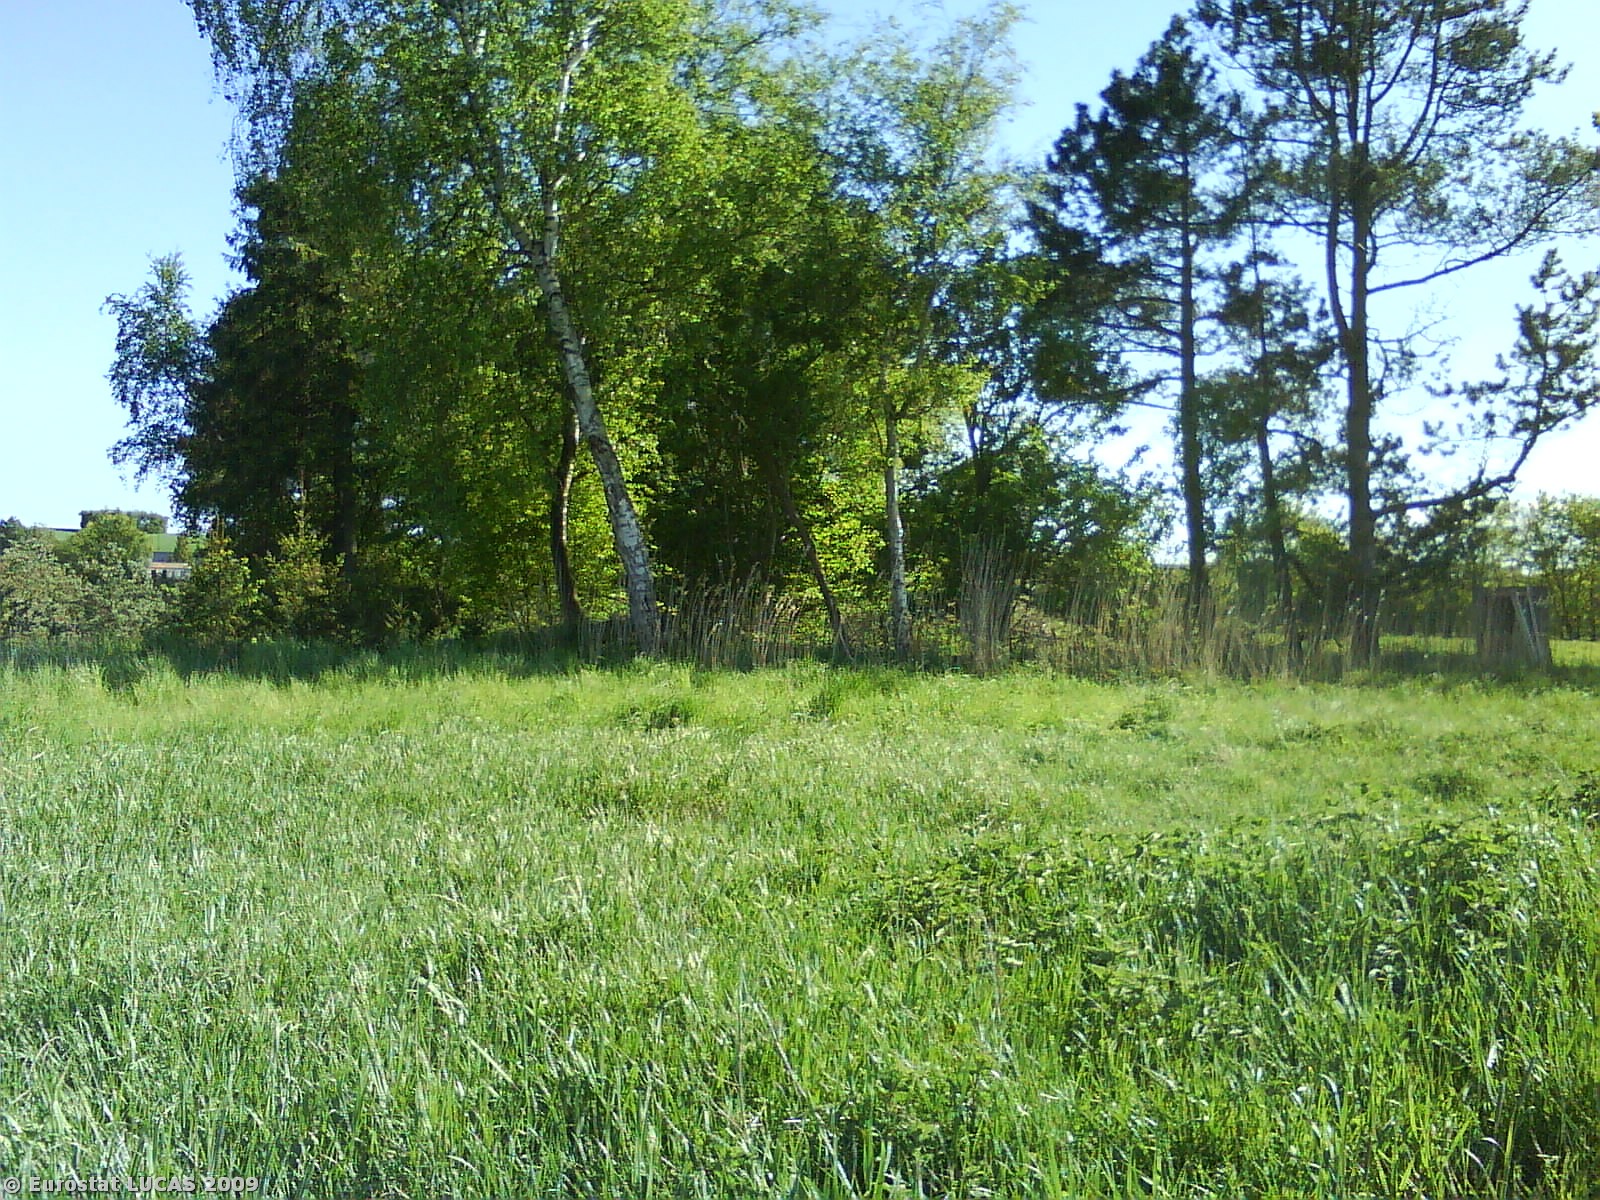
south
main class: Grassland
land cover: Grassland without tree/shrub cover
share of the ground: > 75 %
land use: Unused
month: May
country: DK
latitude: 56.4012
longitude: 10.7606
